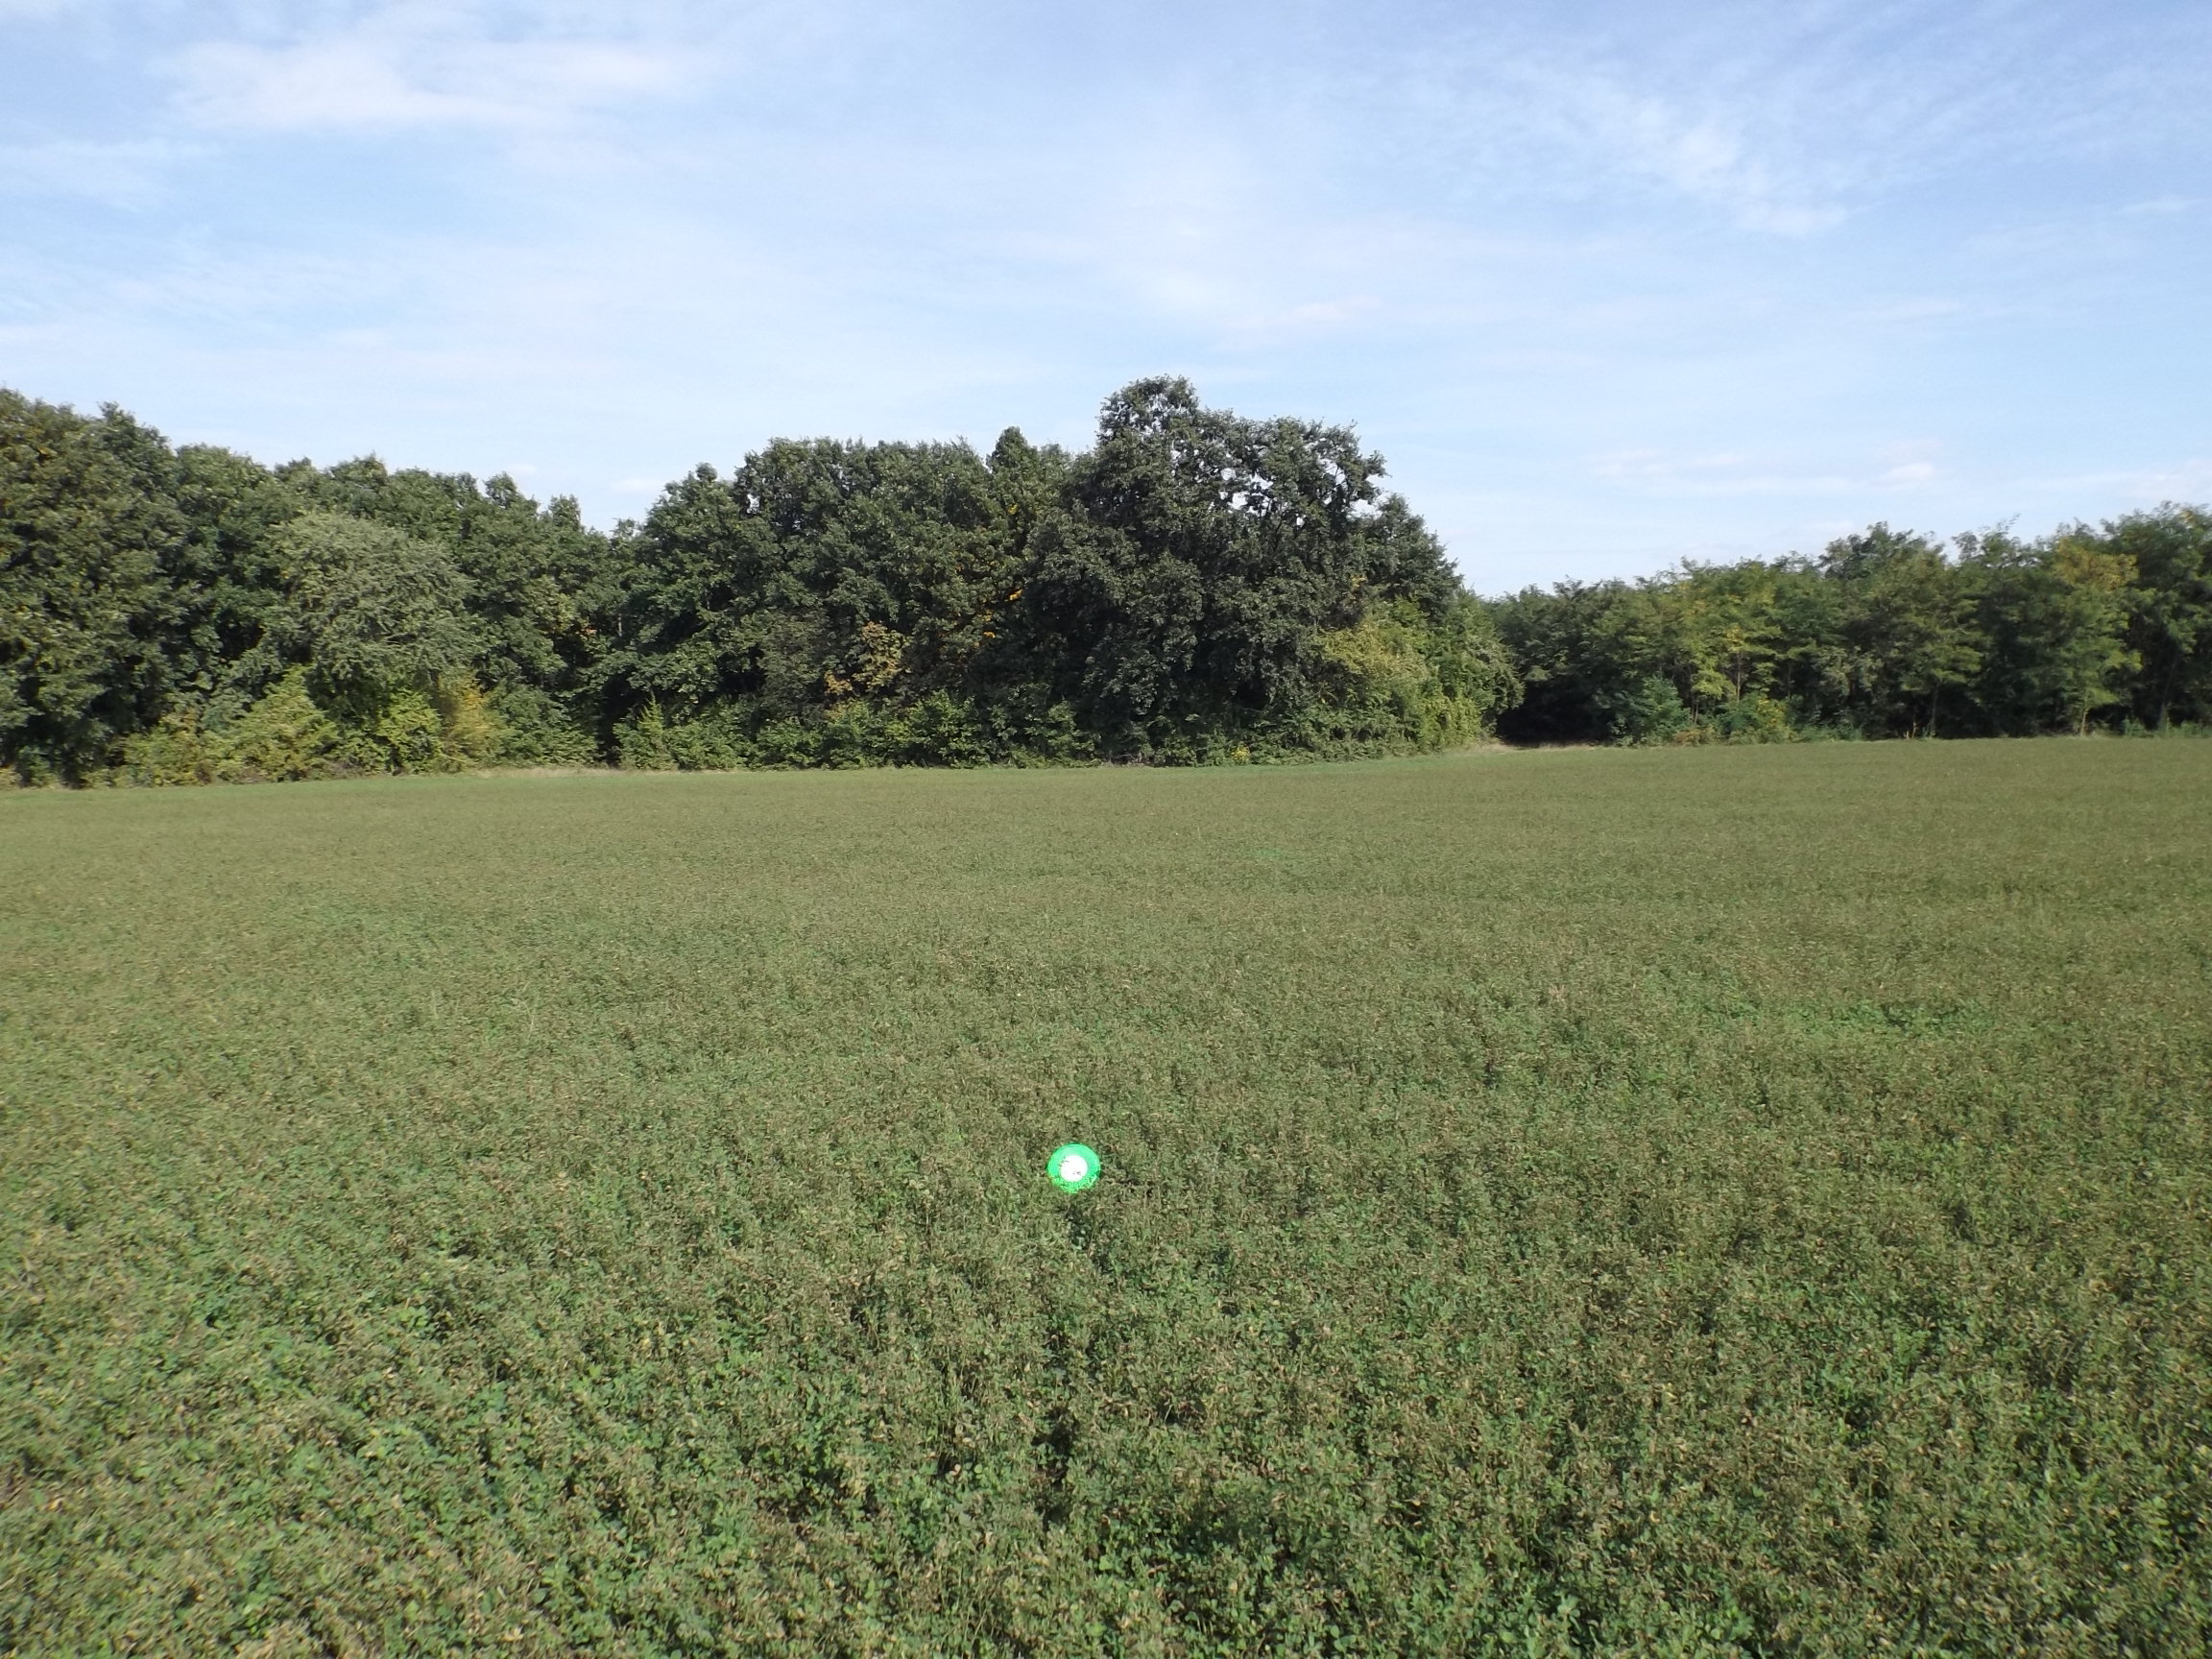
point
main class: Cropland
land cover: Lucerne
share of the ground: > 75 %
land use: Agriculture (excluding fallow land and kitchen gardens)
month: October
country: BG
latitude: 43.8736
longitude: 26.7792
